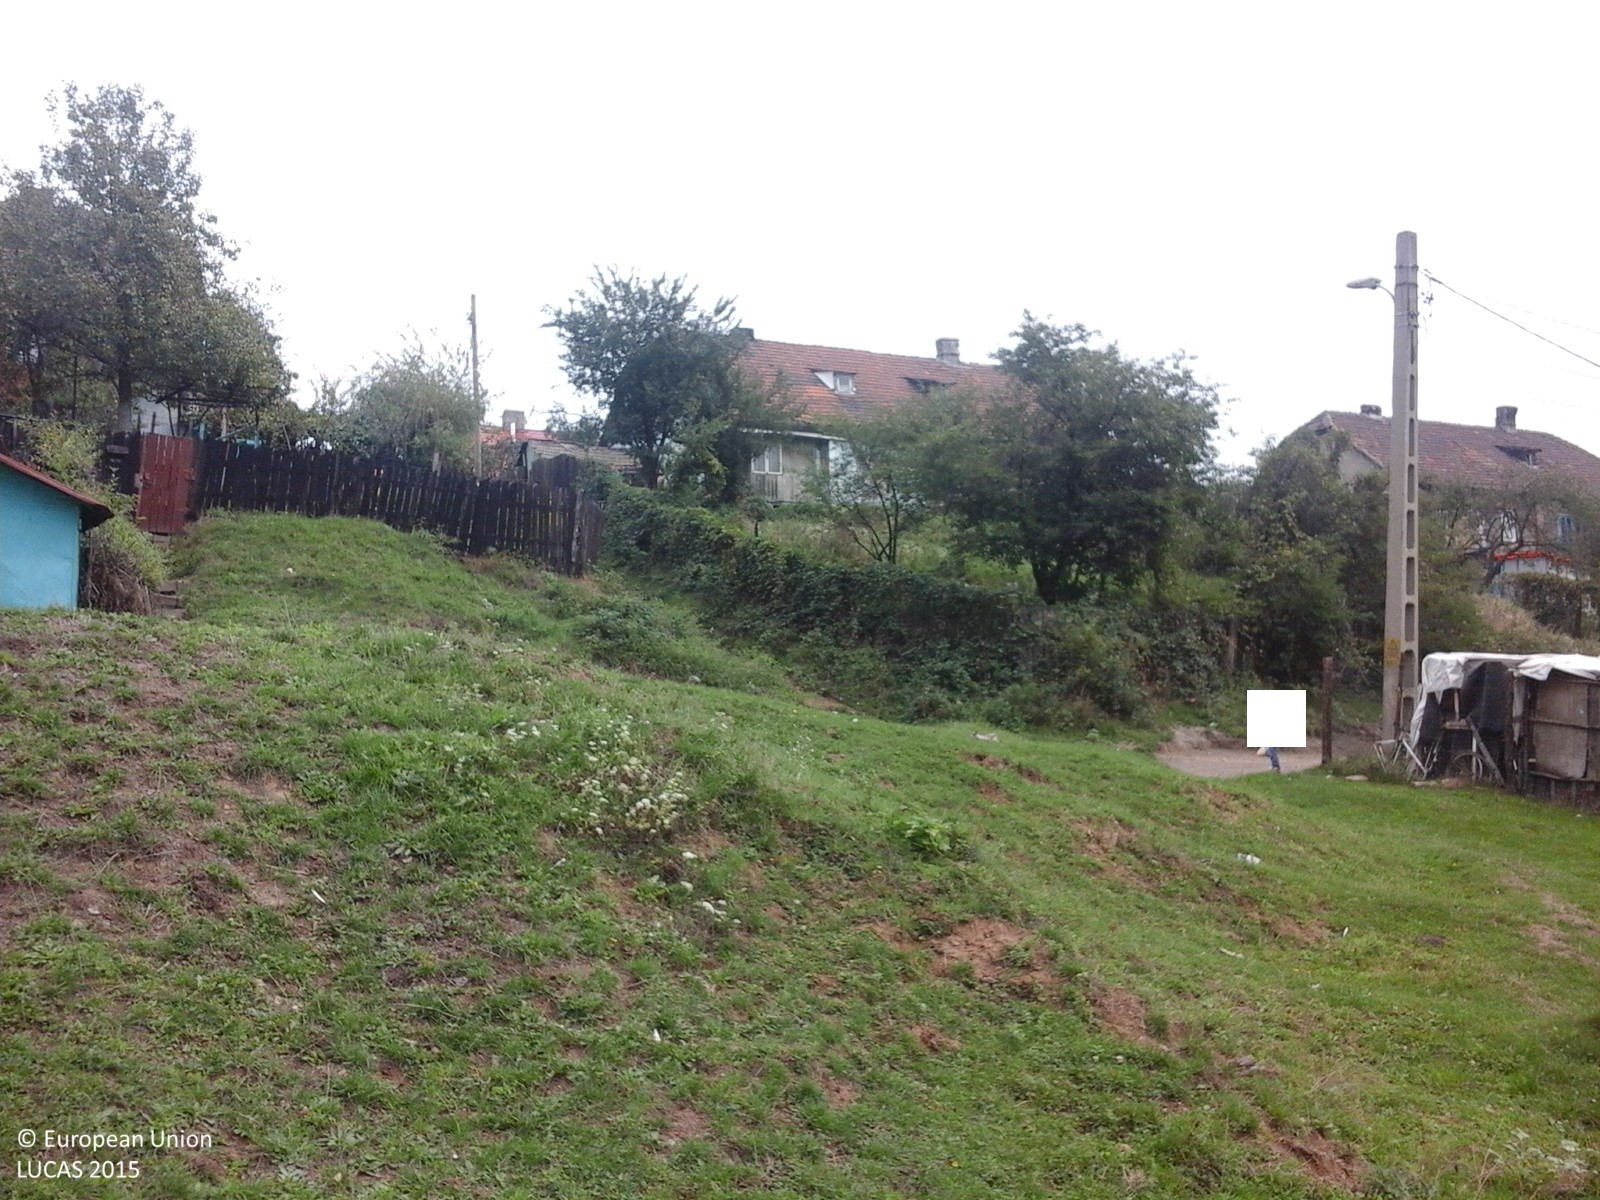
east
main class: Grassland
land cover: Grassland with sparse tree/shrub cover
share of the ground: > 75 %
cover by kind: herbaceous plants 85 %, shrubs 10 %, broadleaved forest trees 5 %
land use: Fallow land
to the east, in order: Grassland with sparse tree/shrub cover; Grassland without tree/shrub cover; Artificial constructions in urban areas
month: September
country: RO
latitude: 45.3625
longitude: 23.2177
